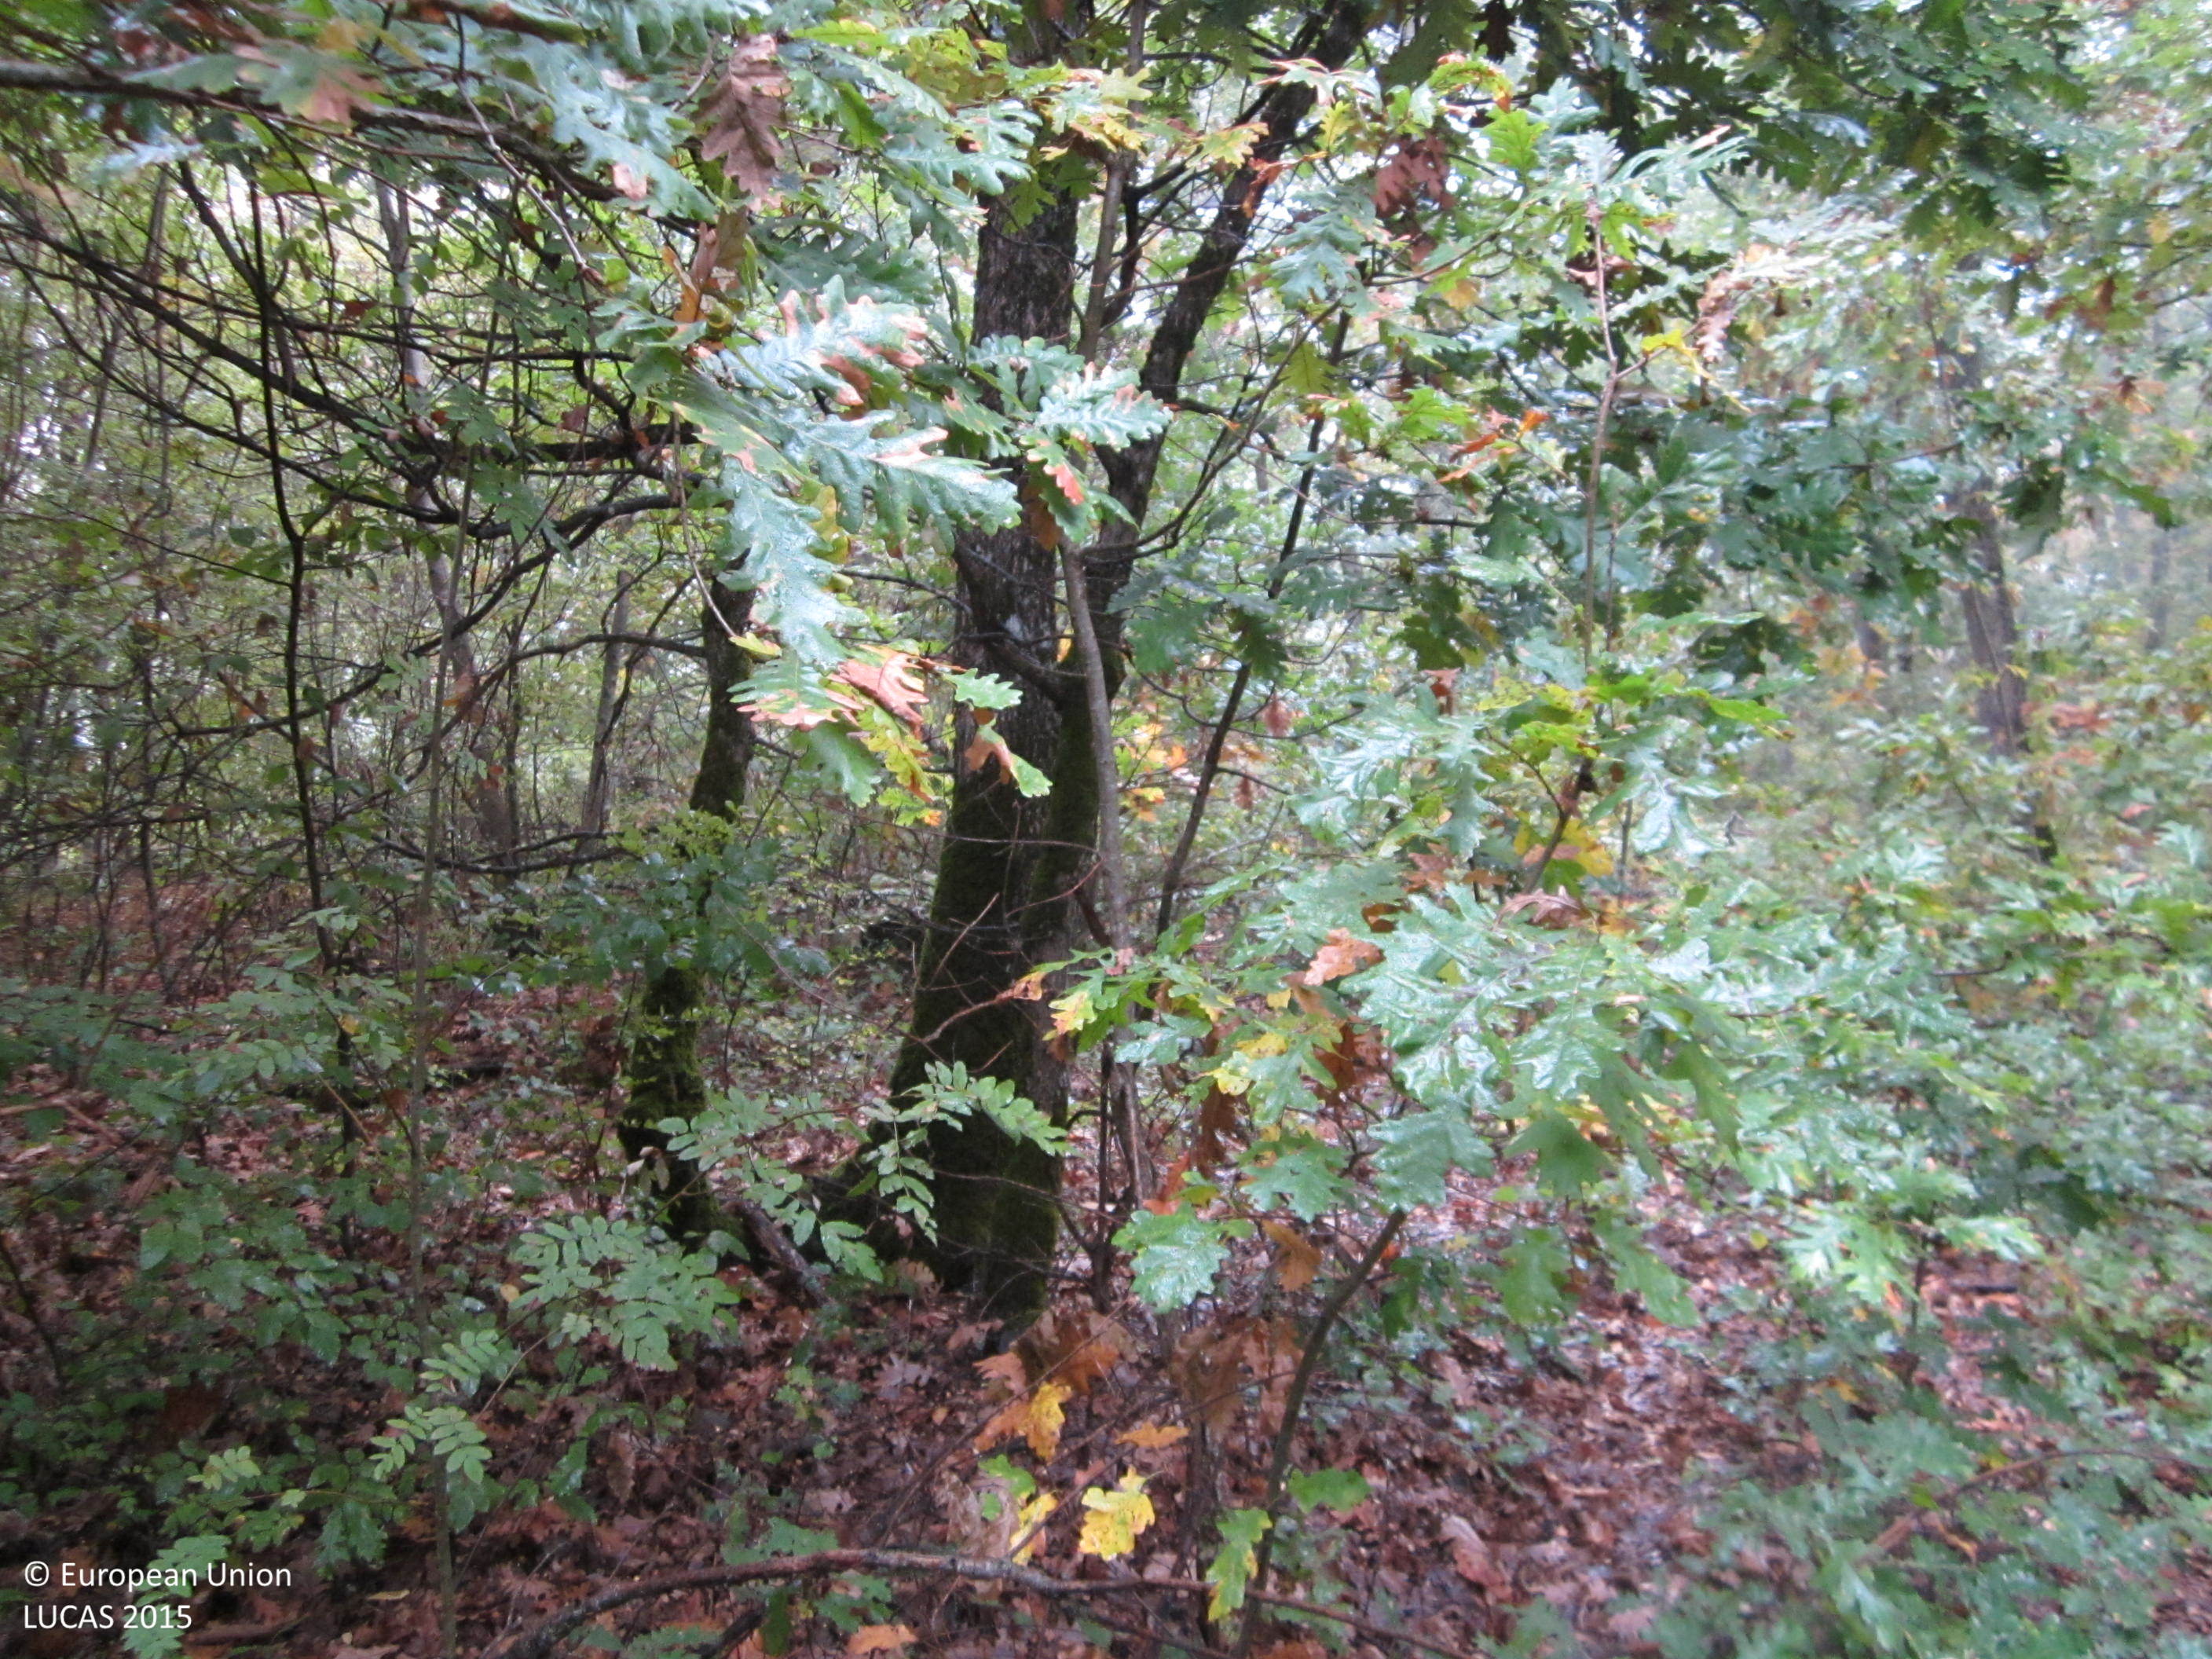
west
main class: Woodland
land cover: Broadleaved woodland
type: acidophilous oak and oak-birch forest
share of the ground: > 75 %
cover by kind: broadleaved forest trees 85 %, shrubs 5 %, herbaceous plants 5 %, unconsolidated bare surface 5 %
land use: Forestry
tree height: > 5 m
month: October
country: BG
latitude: 42.1342
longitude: 27.3735
